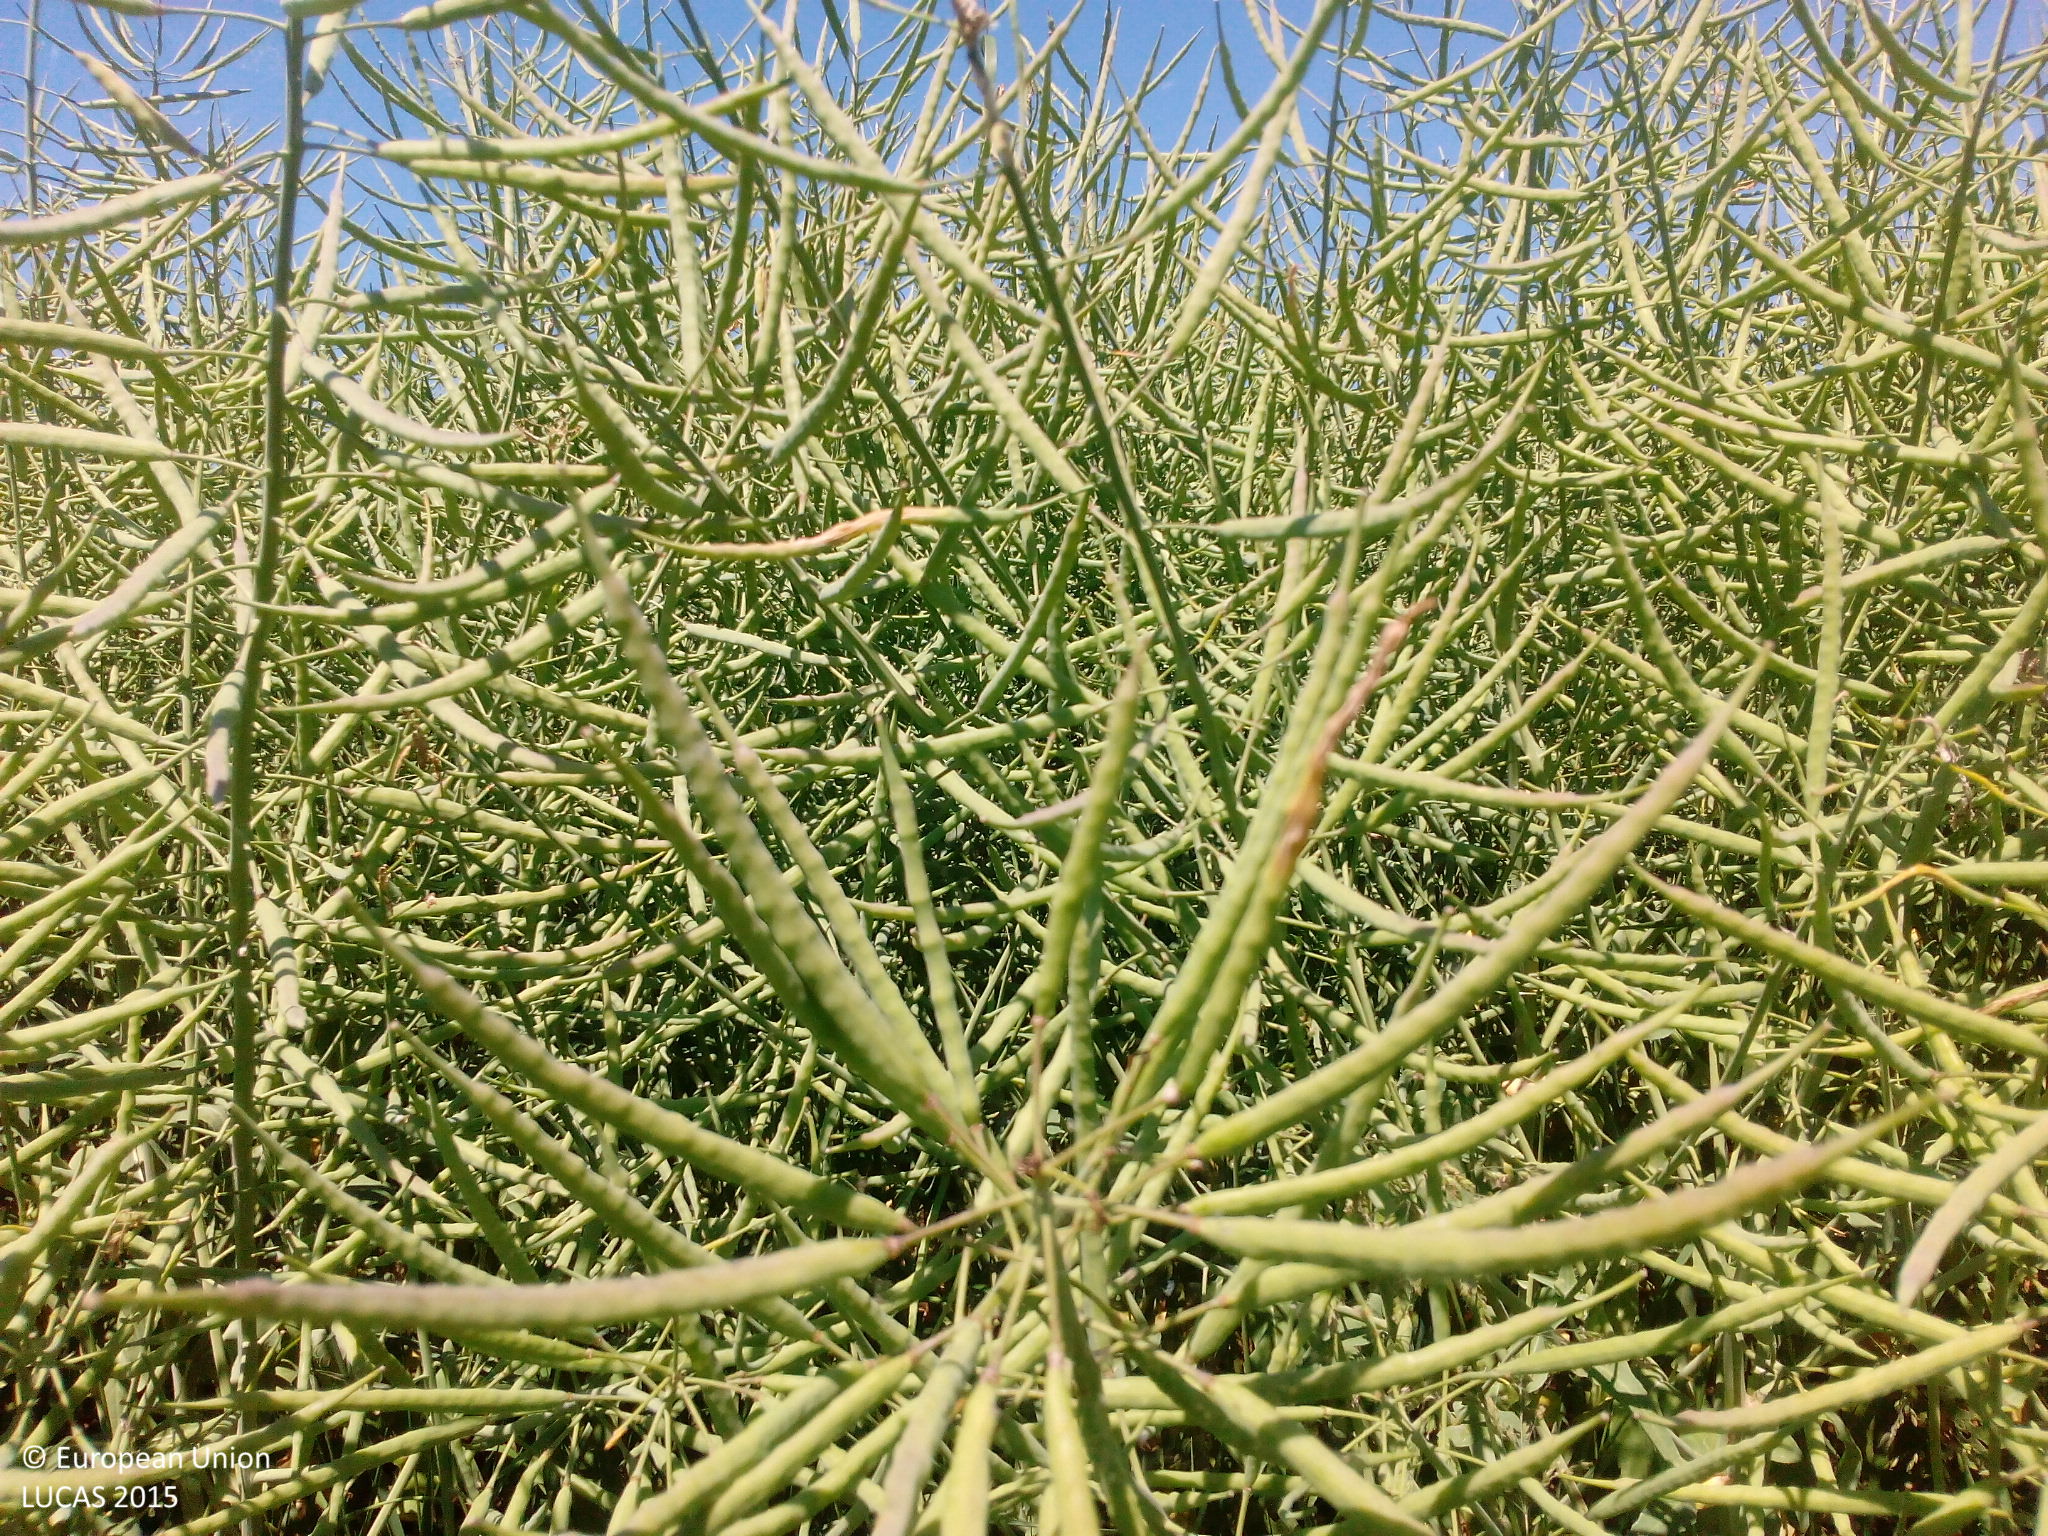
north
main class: Cropland
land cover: Rape and turnip rape
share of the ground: > 75 %
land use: Agriculture (excluding fallow land and kitchen gardens)
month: June
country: DE
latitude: 48.6929
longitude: 11.9148
